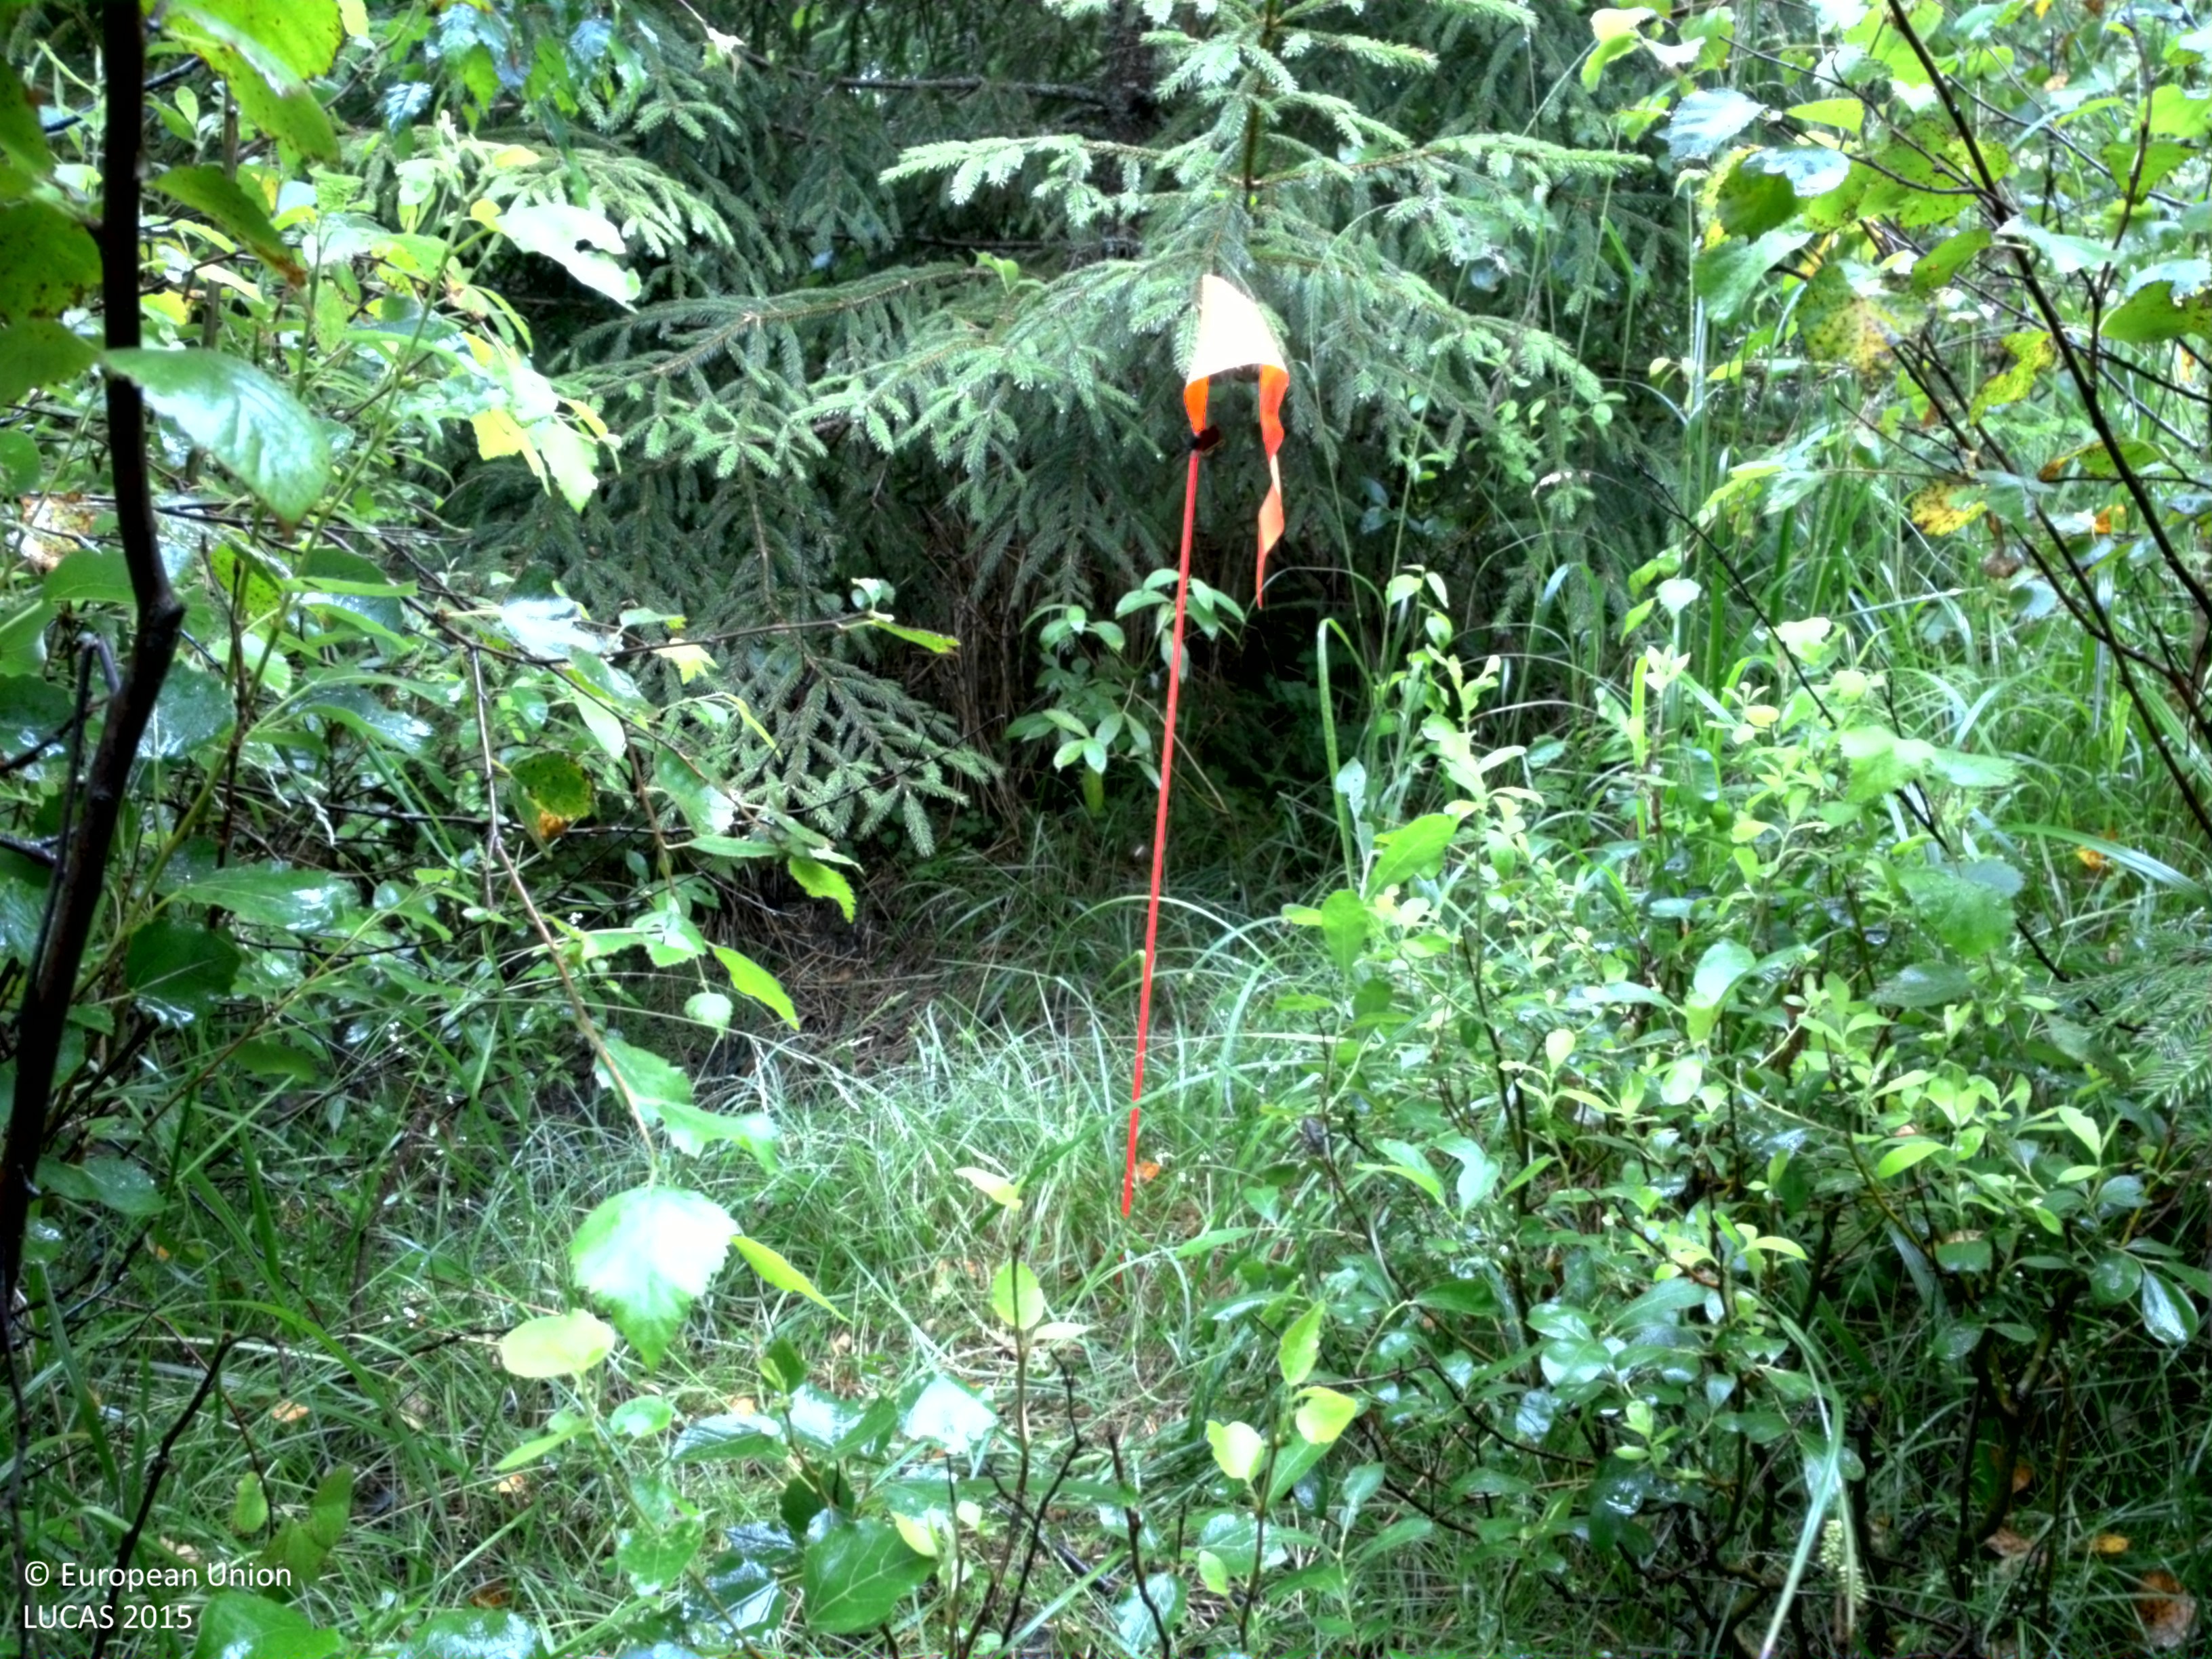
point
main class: Woodland
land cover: Spruce dominated mixed woodland
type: boreal forest
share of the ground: > 75 %
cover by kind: coniferous forest trees 50 %, broadleaved forest trees 40 %, herbaceous plants 5 %, lichens and mosses 5 %
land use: Forestry
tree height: > 5 m
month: July
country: SE
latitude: 59.8592
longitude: 18.3713
